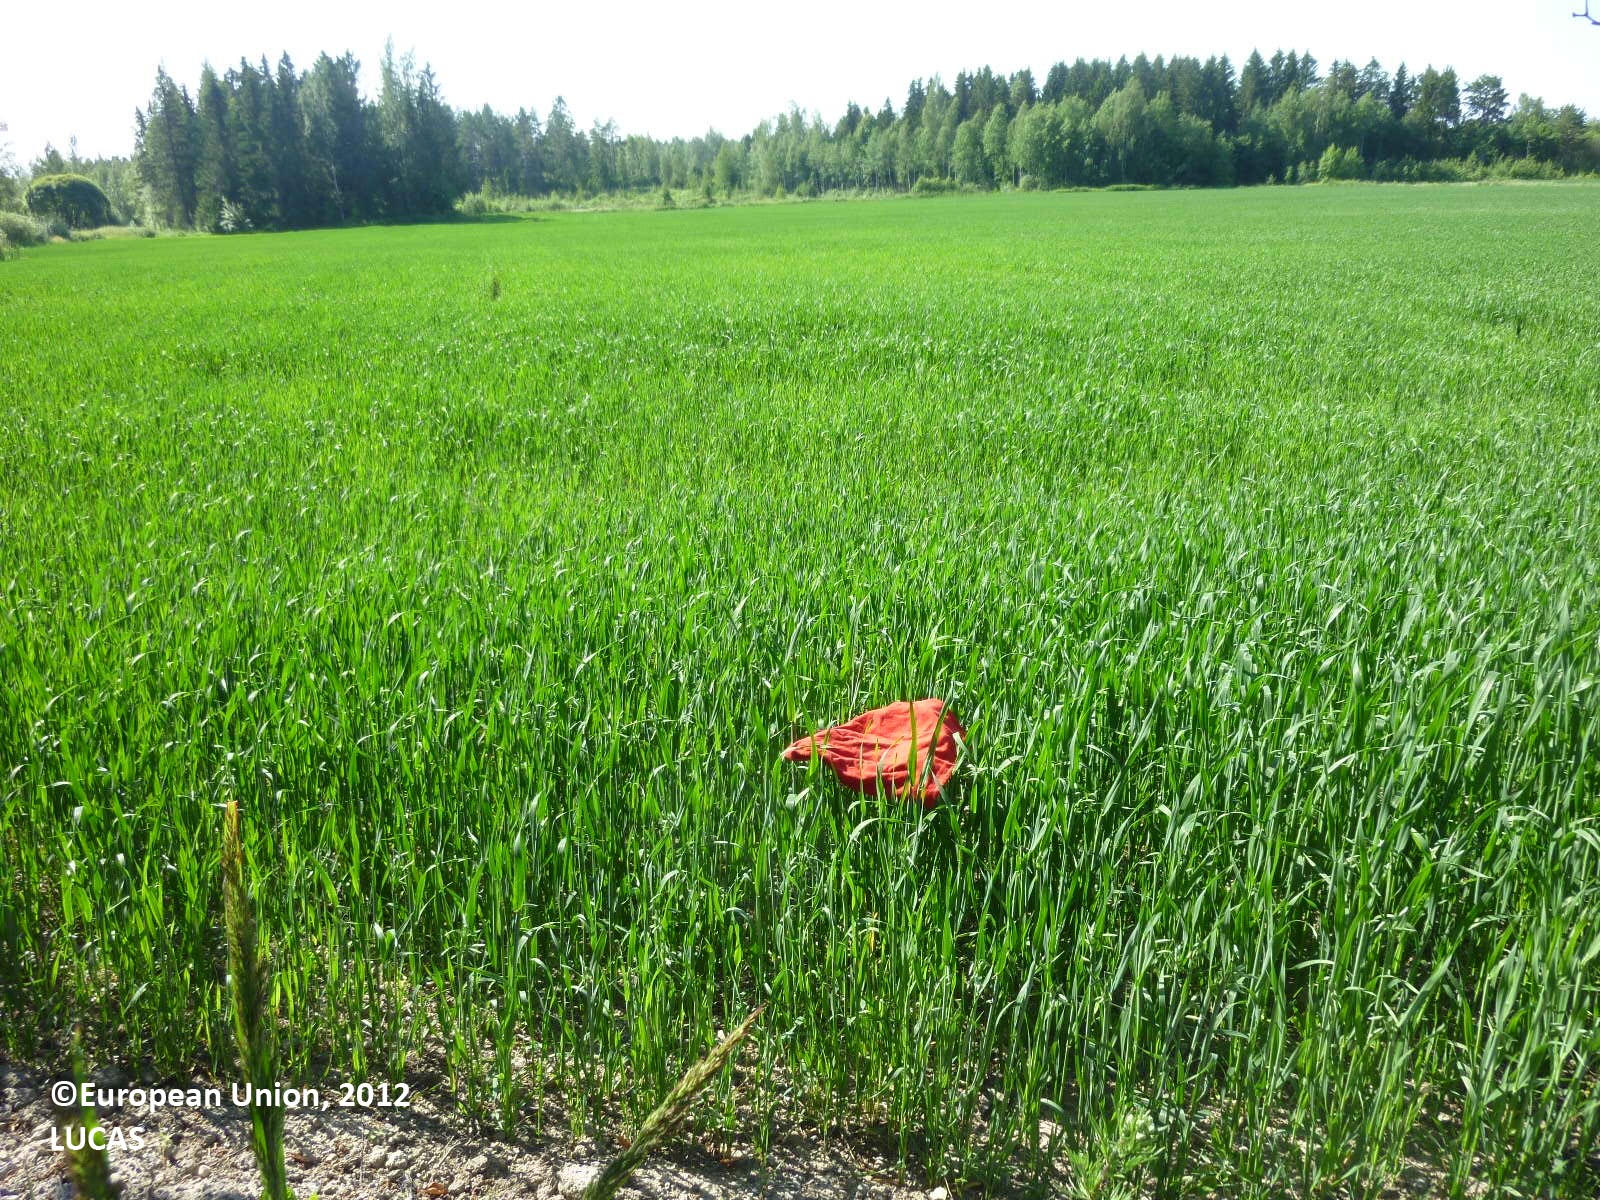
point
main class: Cropland
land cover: Oats
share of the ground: > 75 %
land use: Agriculture (excluding fallow land and kitchen gardens)
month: July
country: FI
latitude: 61.2931
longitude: 22.3997
